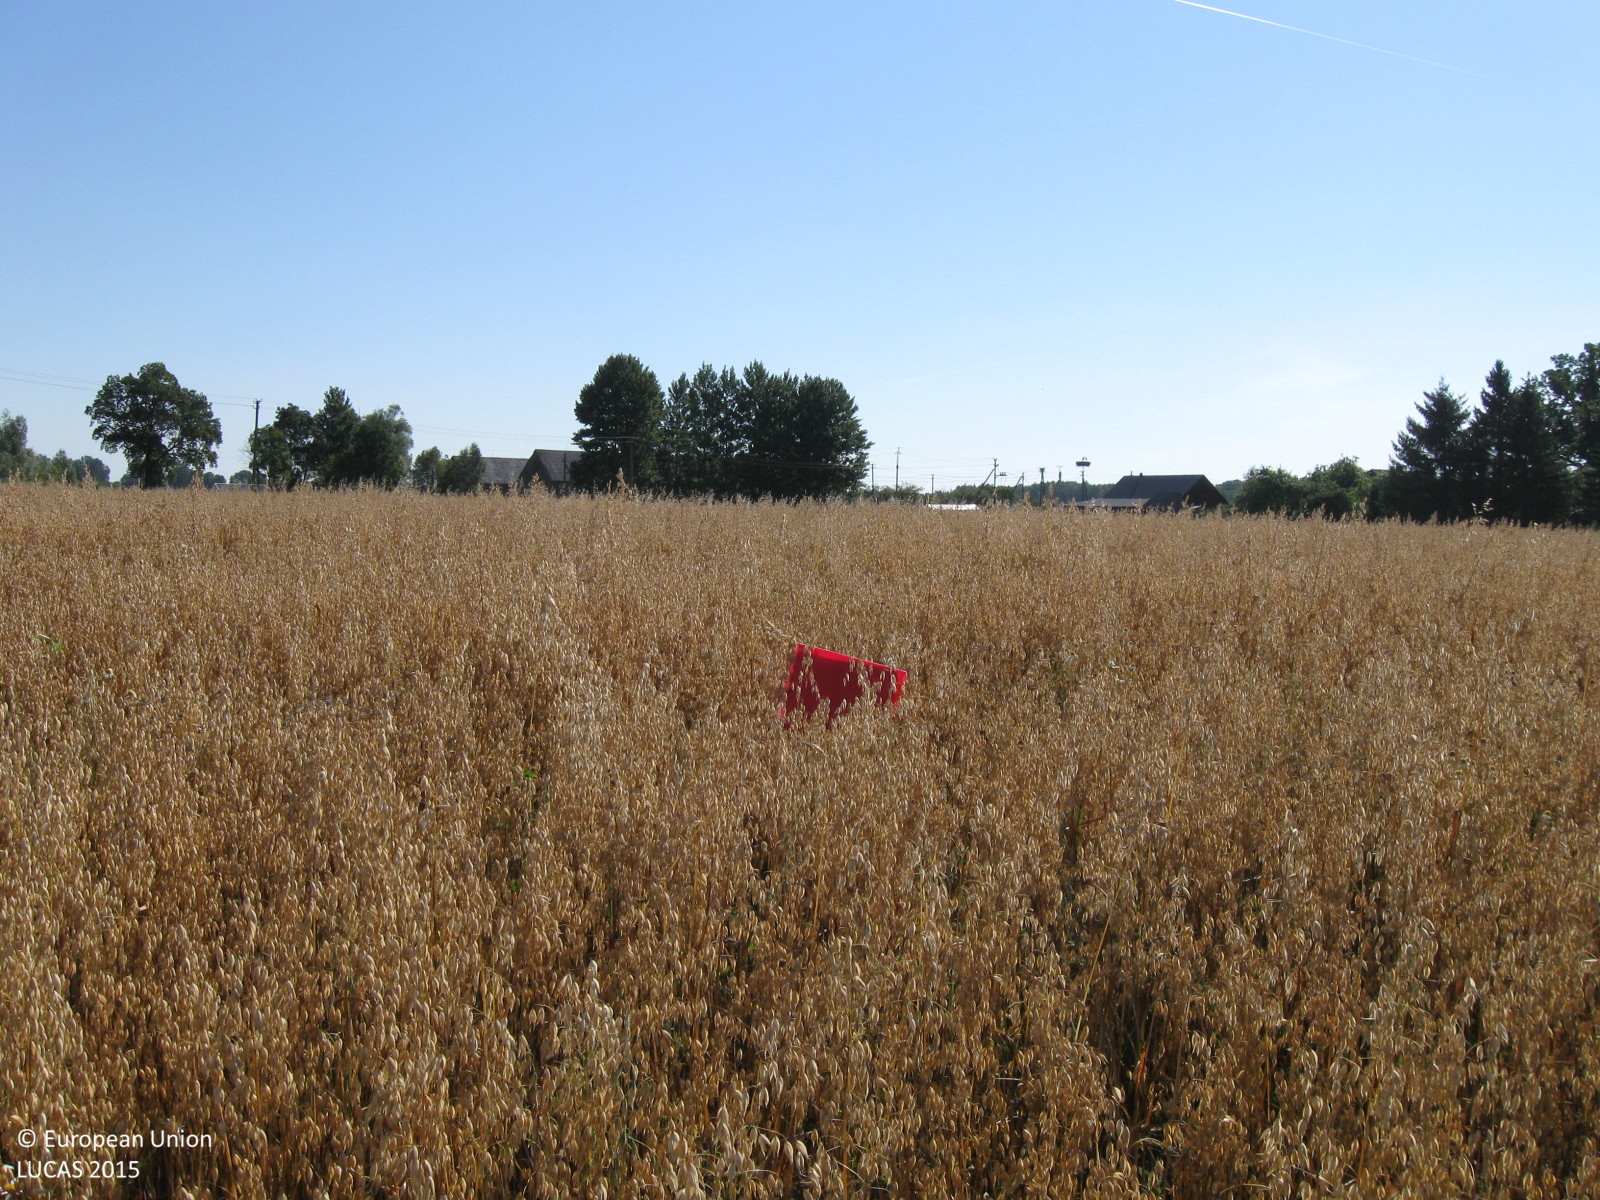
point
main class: Cropland
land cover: Oats
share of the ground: > 75 %
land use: Agriculture (excluding fallow land and kitchen gardens)
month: August
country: LT
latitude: 55.4104
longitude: 22.4917
